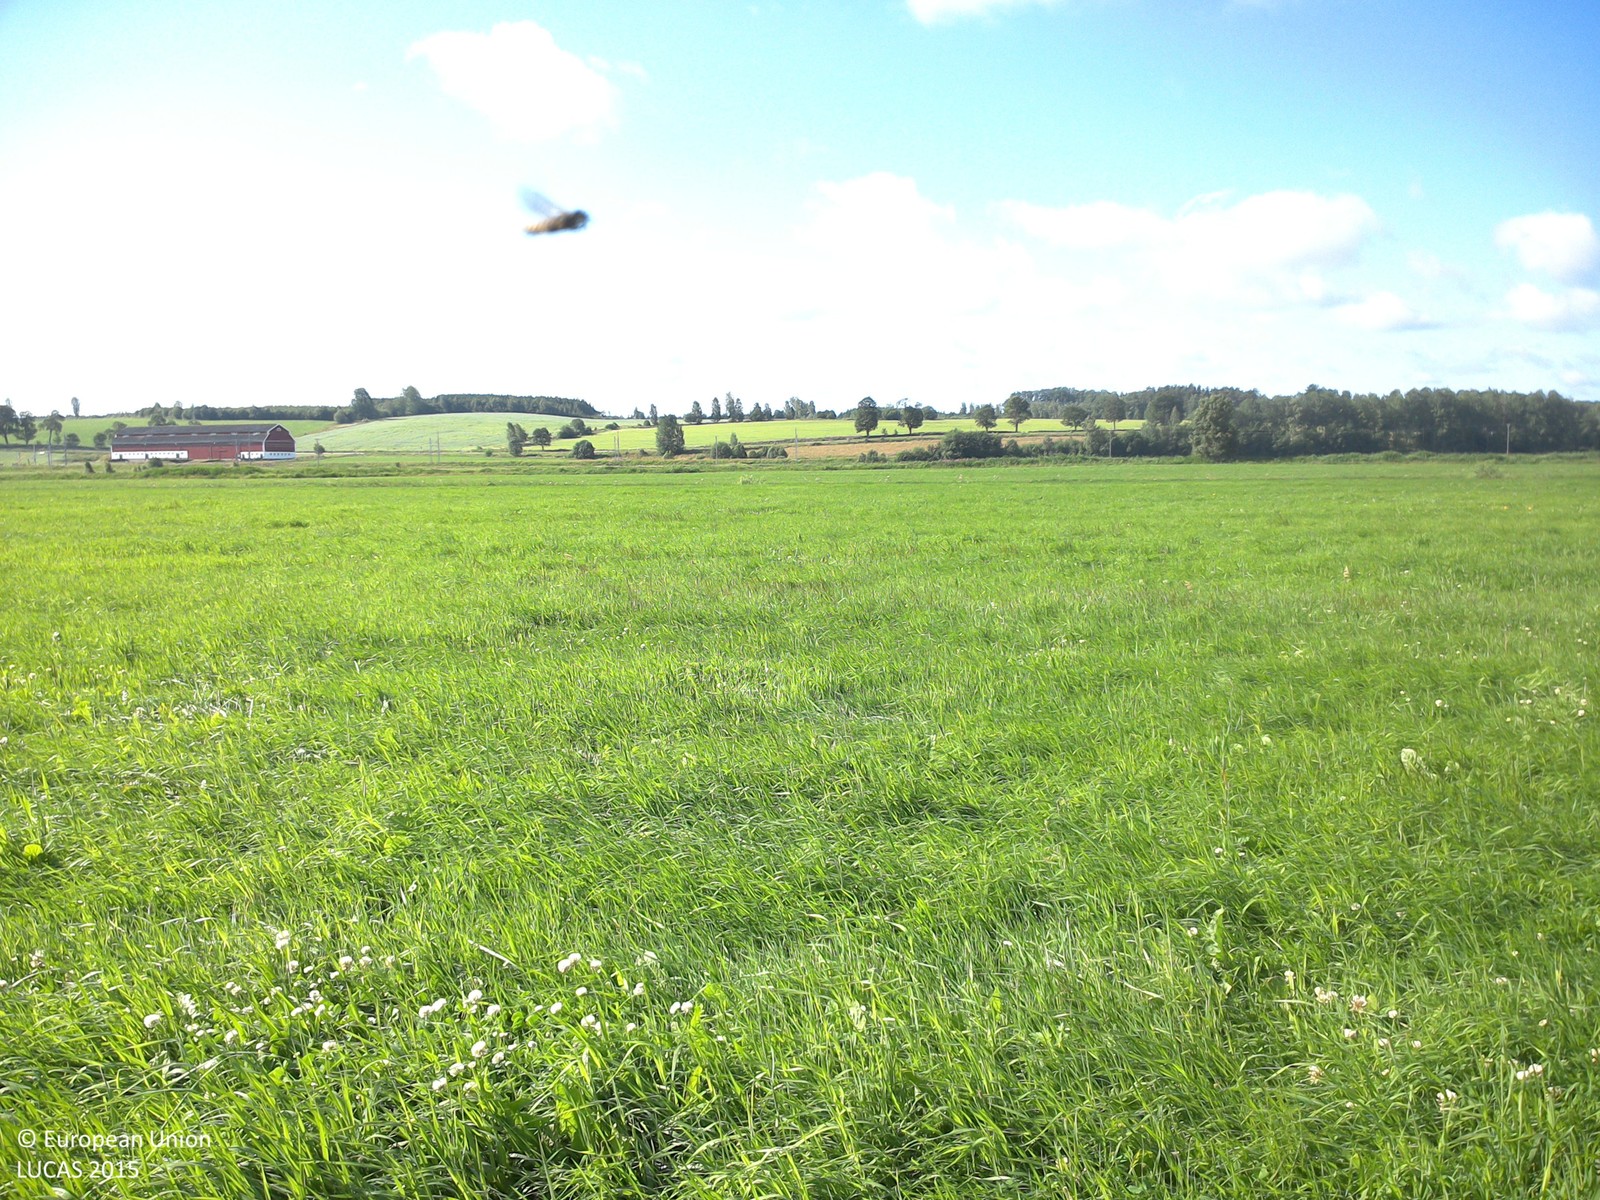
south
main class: Cropland
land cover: Other leguminous and mixtures for fodder
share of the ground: > 75 %
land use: Agriculture (excluding fallow land and kitchen gardens)
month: July
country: SE
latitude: 58.0046
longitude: 14.8851
